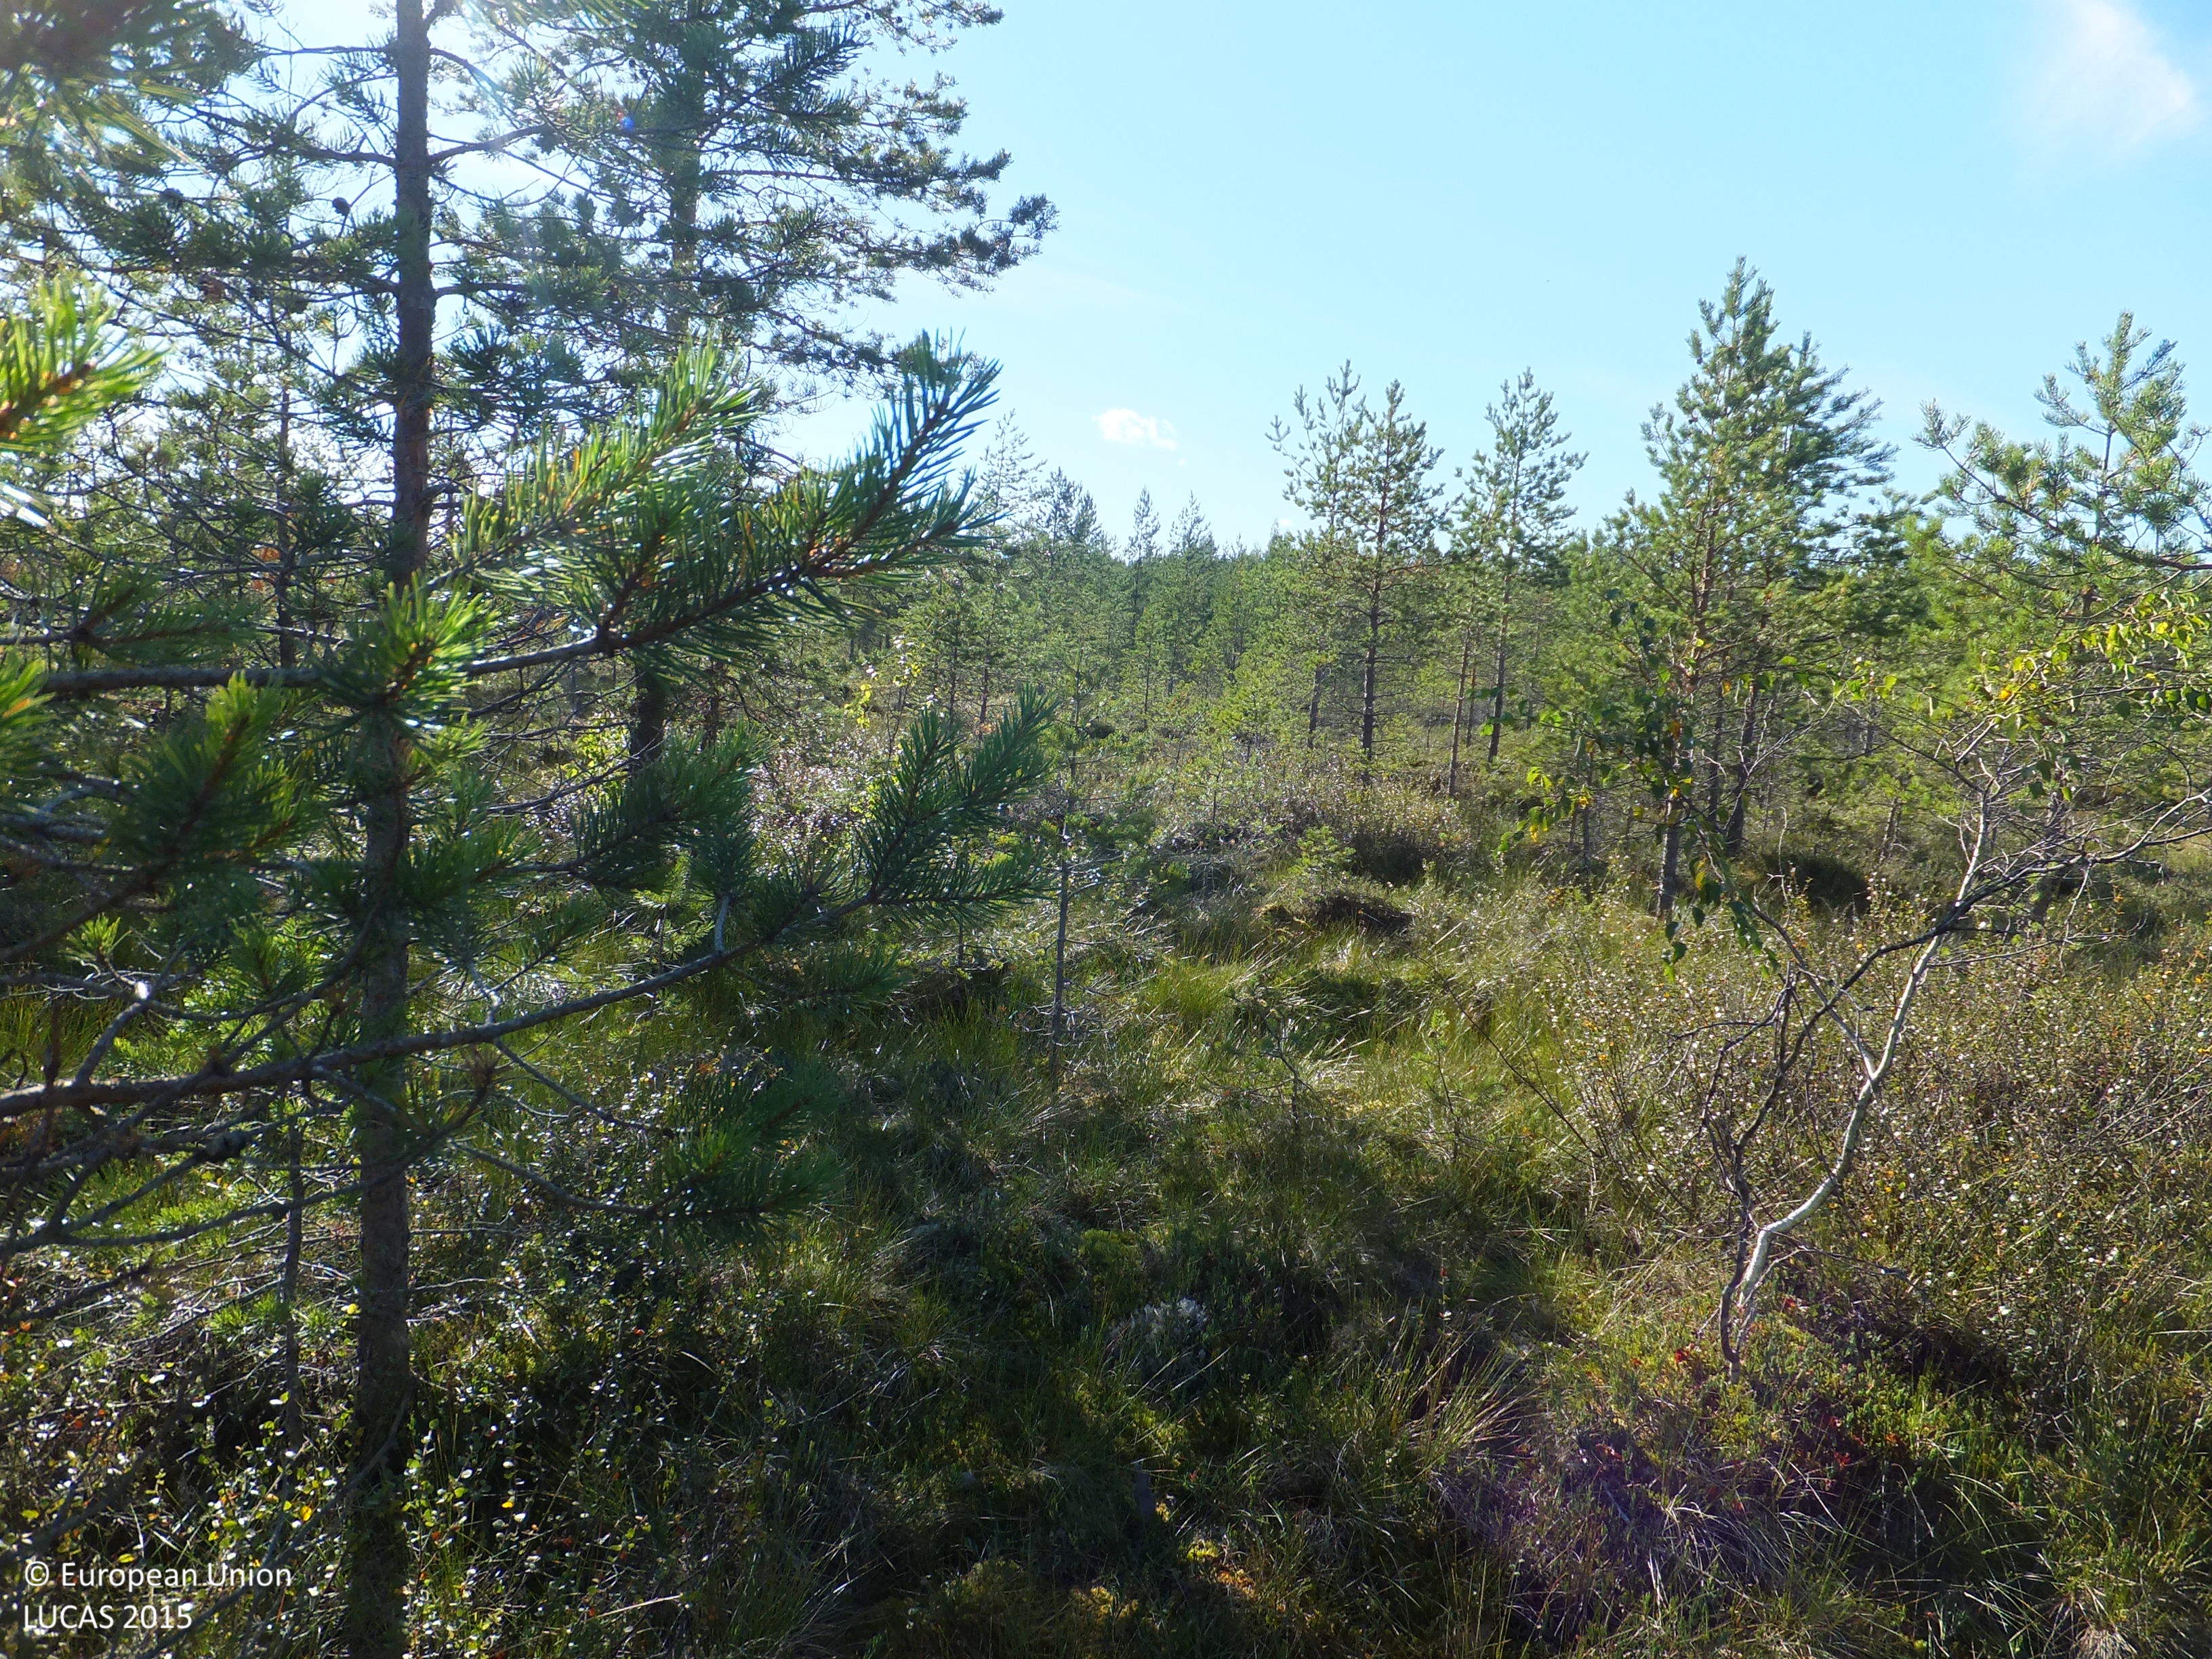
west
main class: Woodland
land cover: Pine dominated coniferous woodland
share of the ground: 25 - 50 %
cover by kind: coniferous forest trees 35 %, lichens and mosses 30 %, shrubs 20 %, herbaceous plants 10 %, broadleaved forest trees 5 %
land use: Forestry
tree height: < 5 m
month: August
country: FI
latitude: 63.1762
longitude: 23.0687
